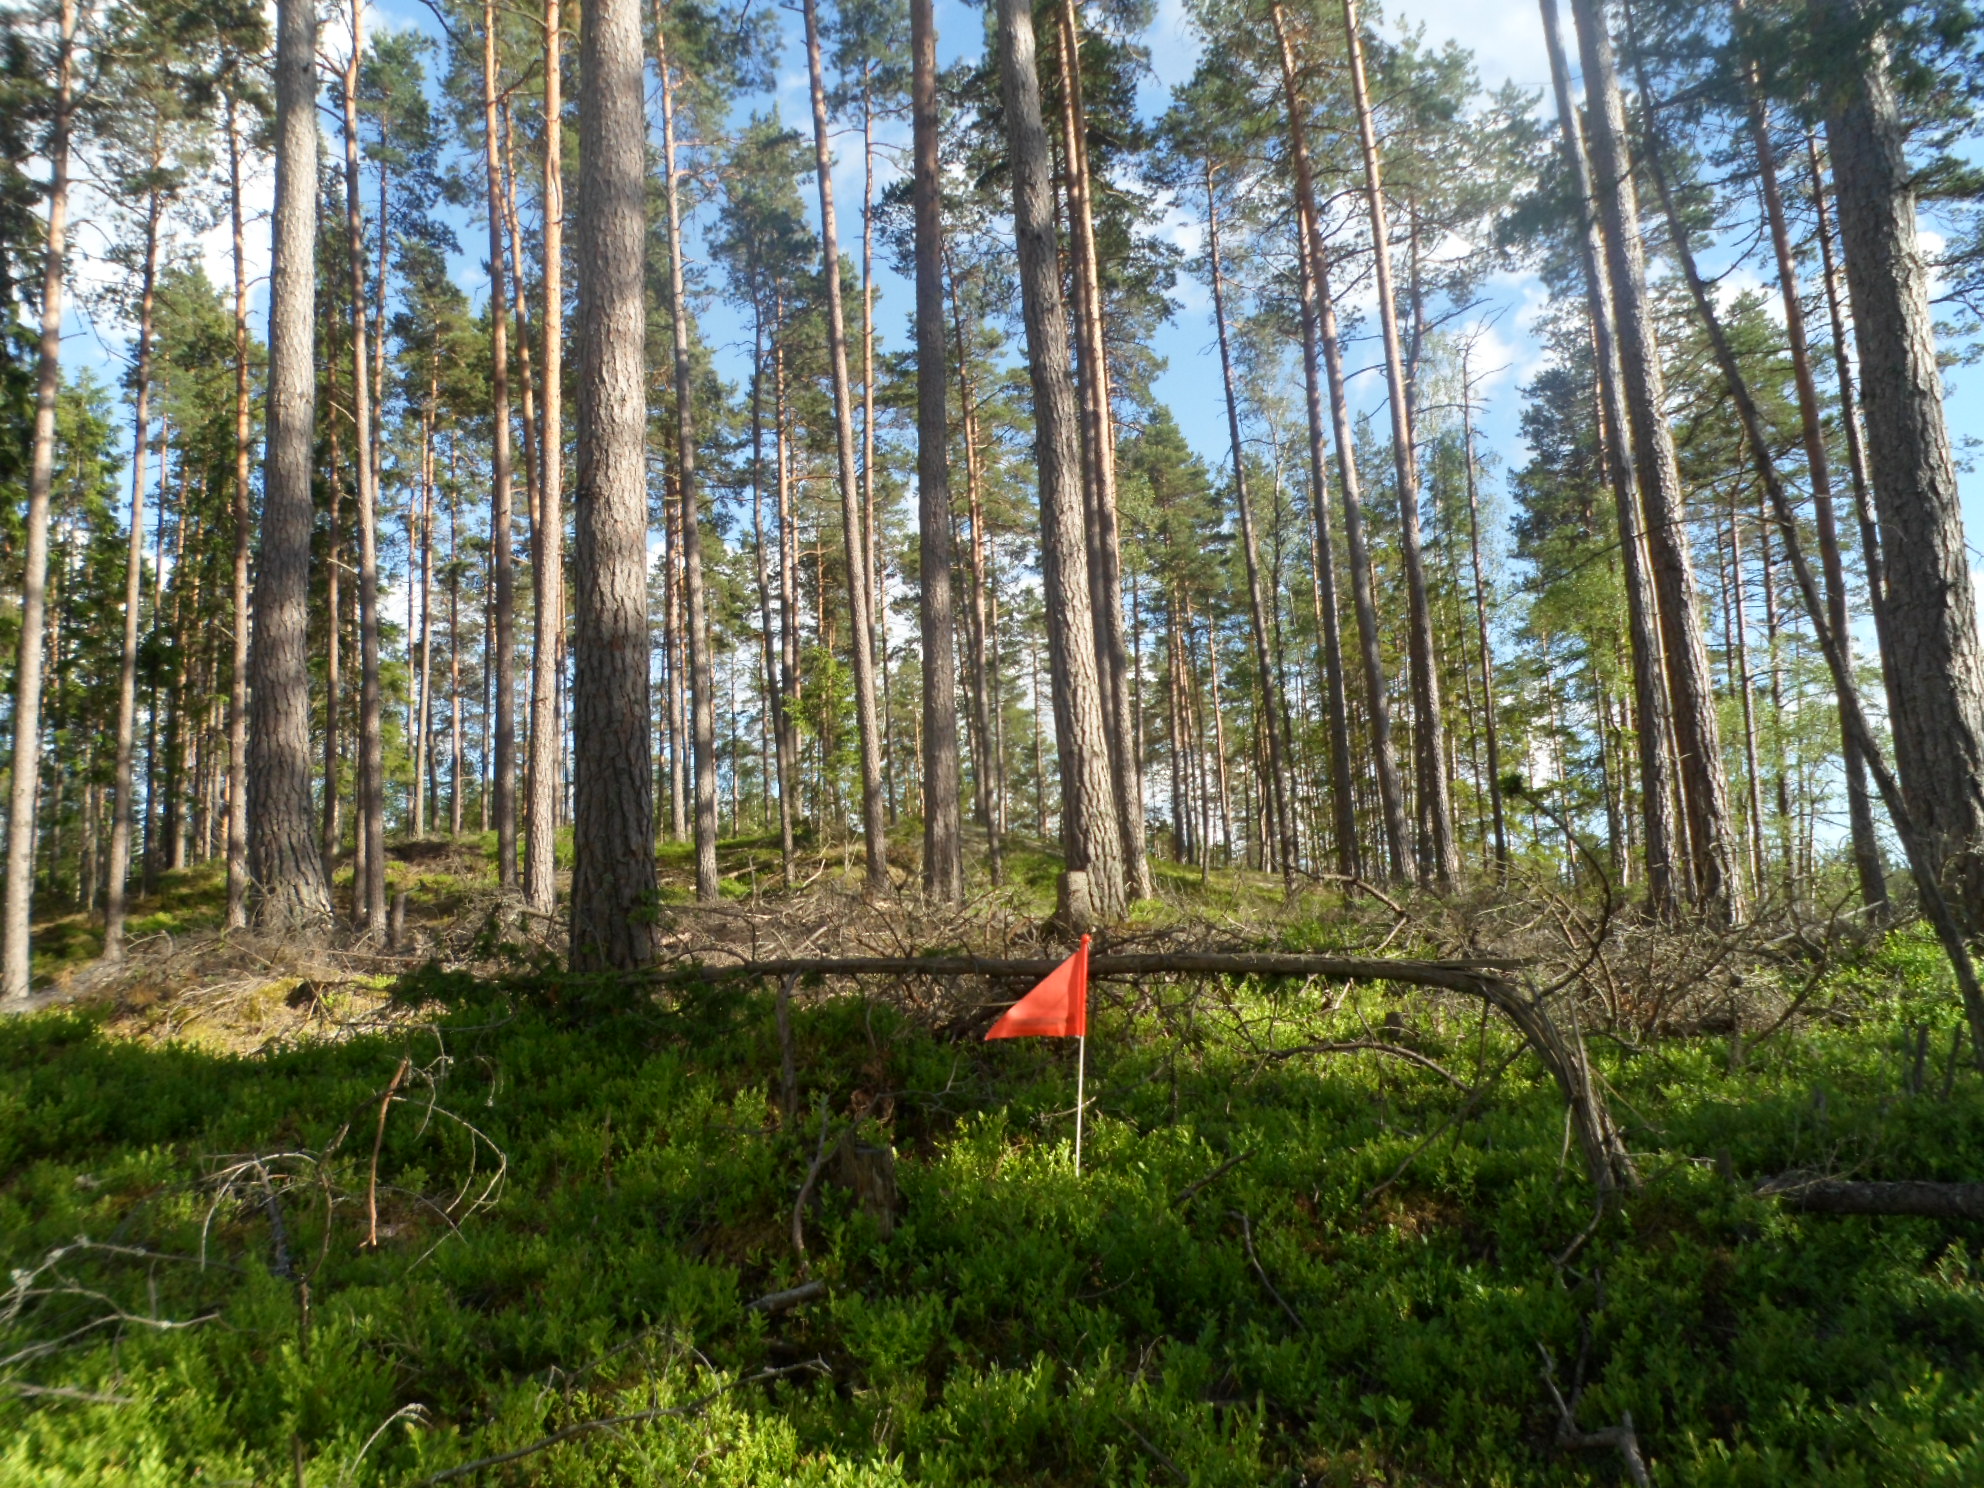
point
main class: Woodland
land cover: Pine dominated coniferous woodland
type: boreal forest
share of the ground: 25 - 50 %
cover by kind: coniferous forest trees 35 %, shrubs 30 %, herbaceous plants 10 %, lichens and mosses 10 %, unconsolidated bare surface 10 %, broadleaved forest trees 5 %
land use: Forestry
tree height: > 5 m
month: June
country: SE
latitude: 57.2024
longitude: 14.6477
